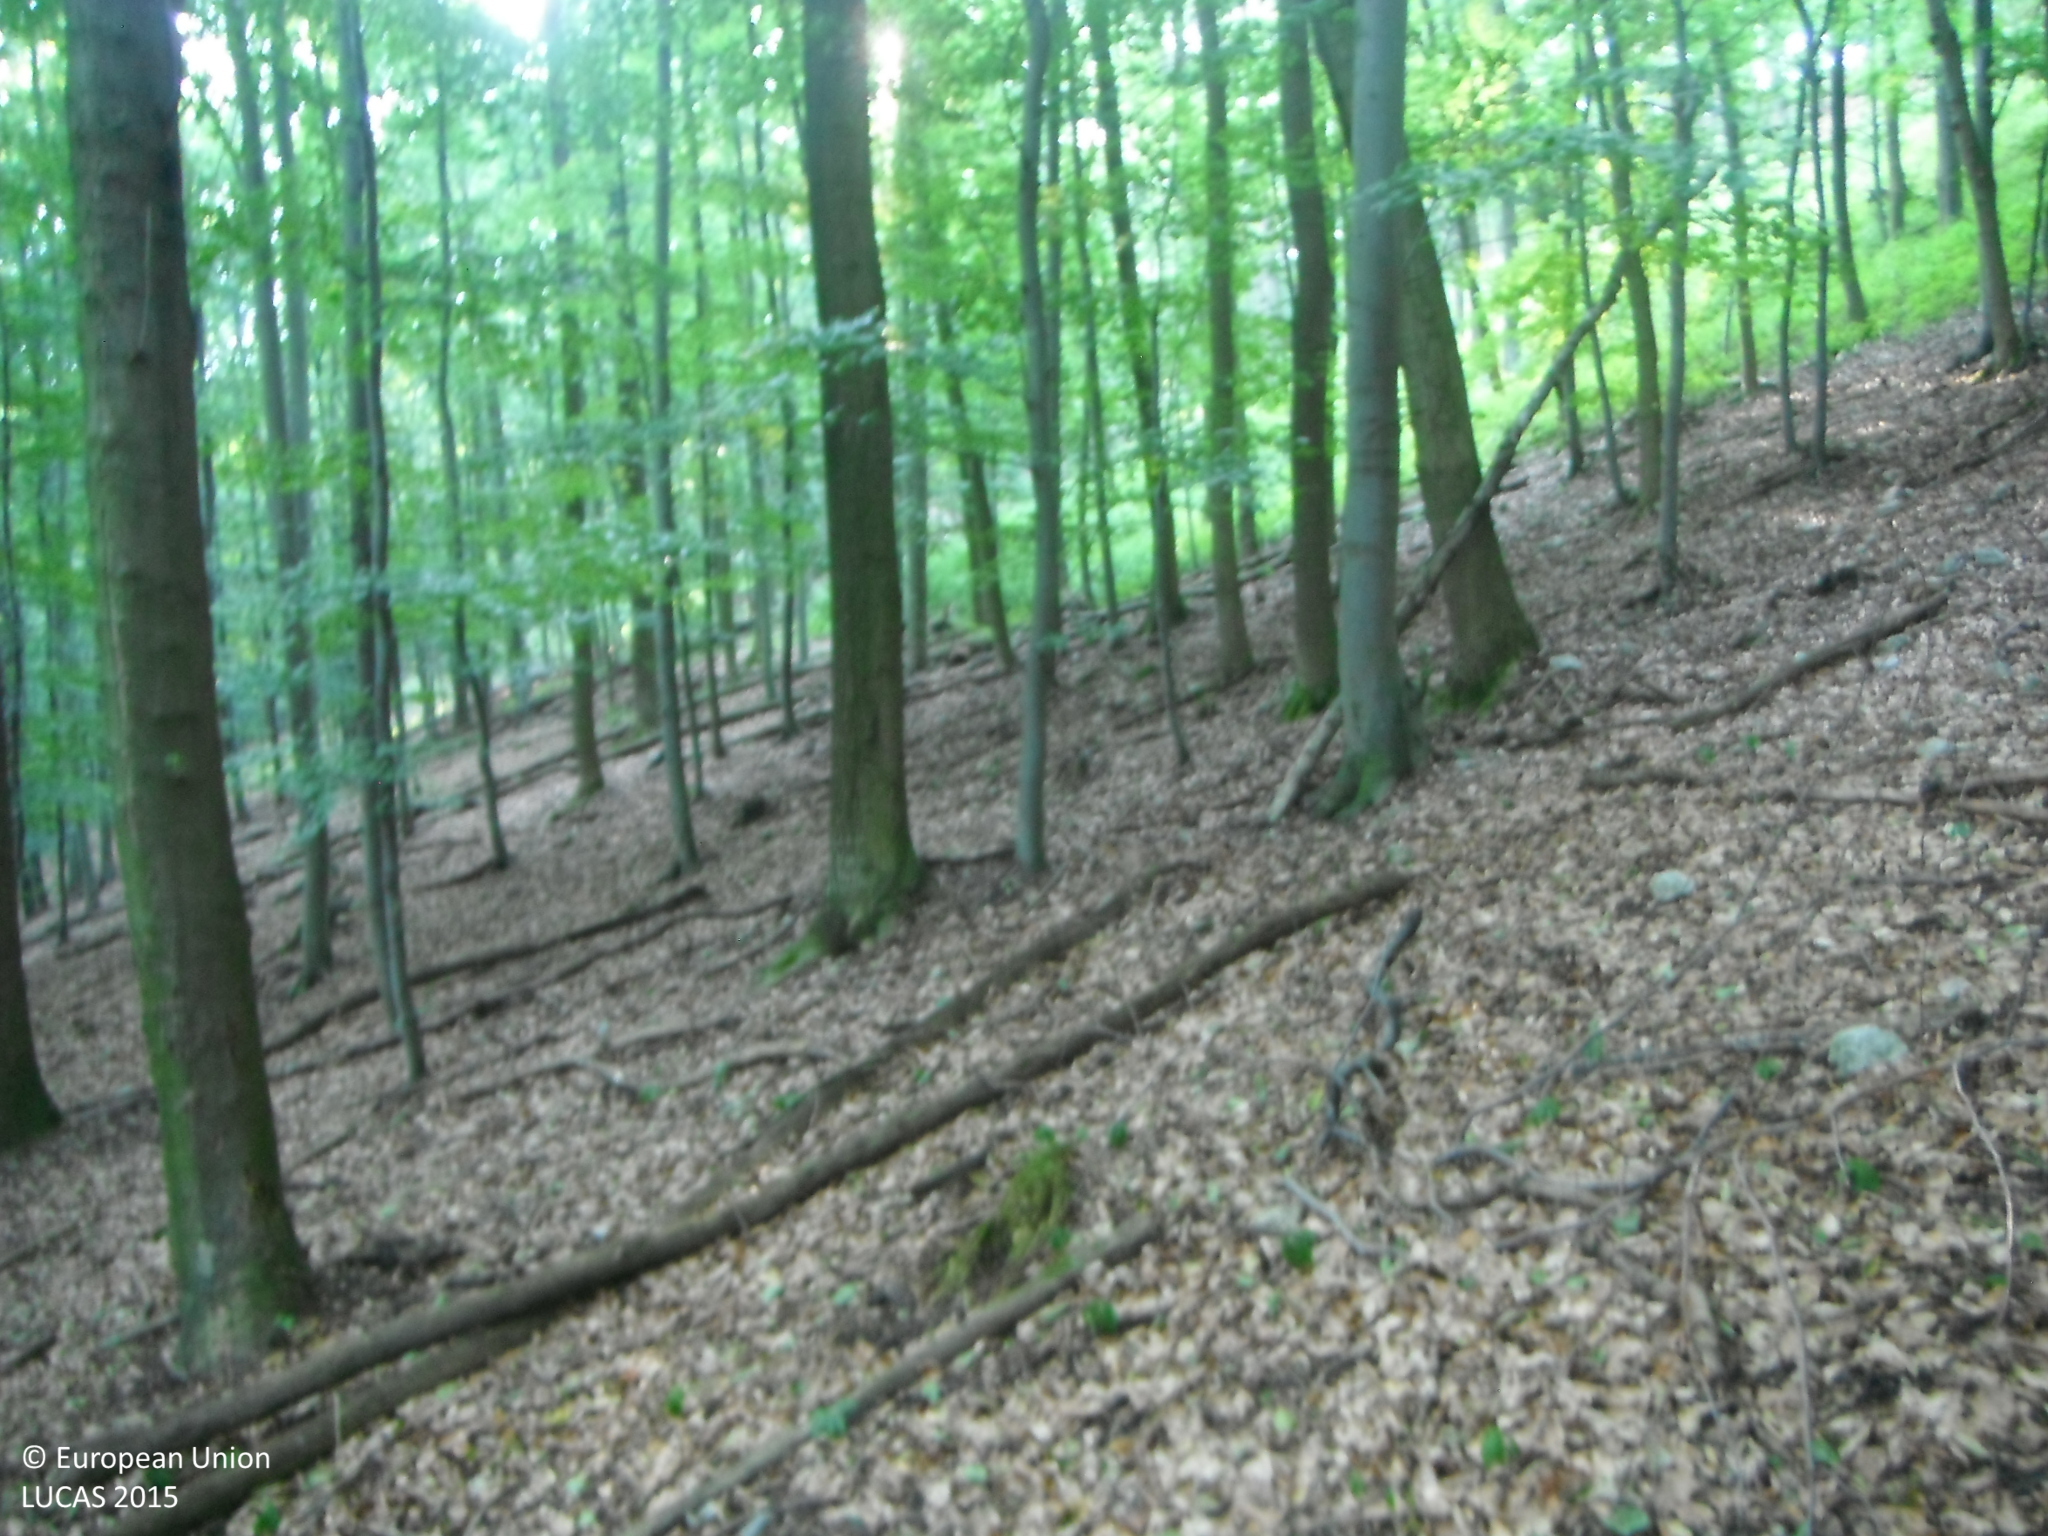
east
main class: Woodland
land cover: Broadleaved woodland
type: beech forest
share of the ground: > 75 %
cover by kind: broadleaved forest trees 95 %, consolidated bare surface 5 %
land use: Forestry
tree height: > 5 m
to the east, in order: Broadleaved woodland; Tracks; Broadleaved woodland
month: August
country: SK
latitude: 48.6053
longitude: 17.9471
